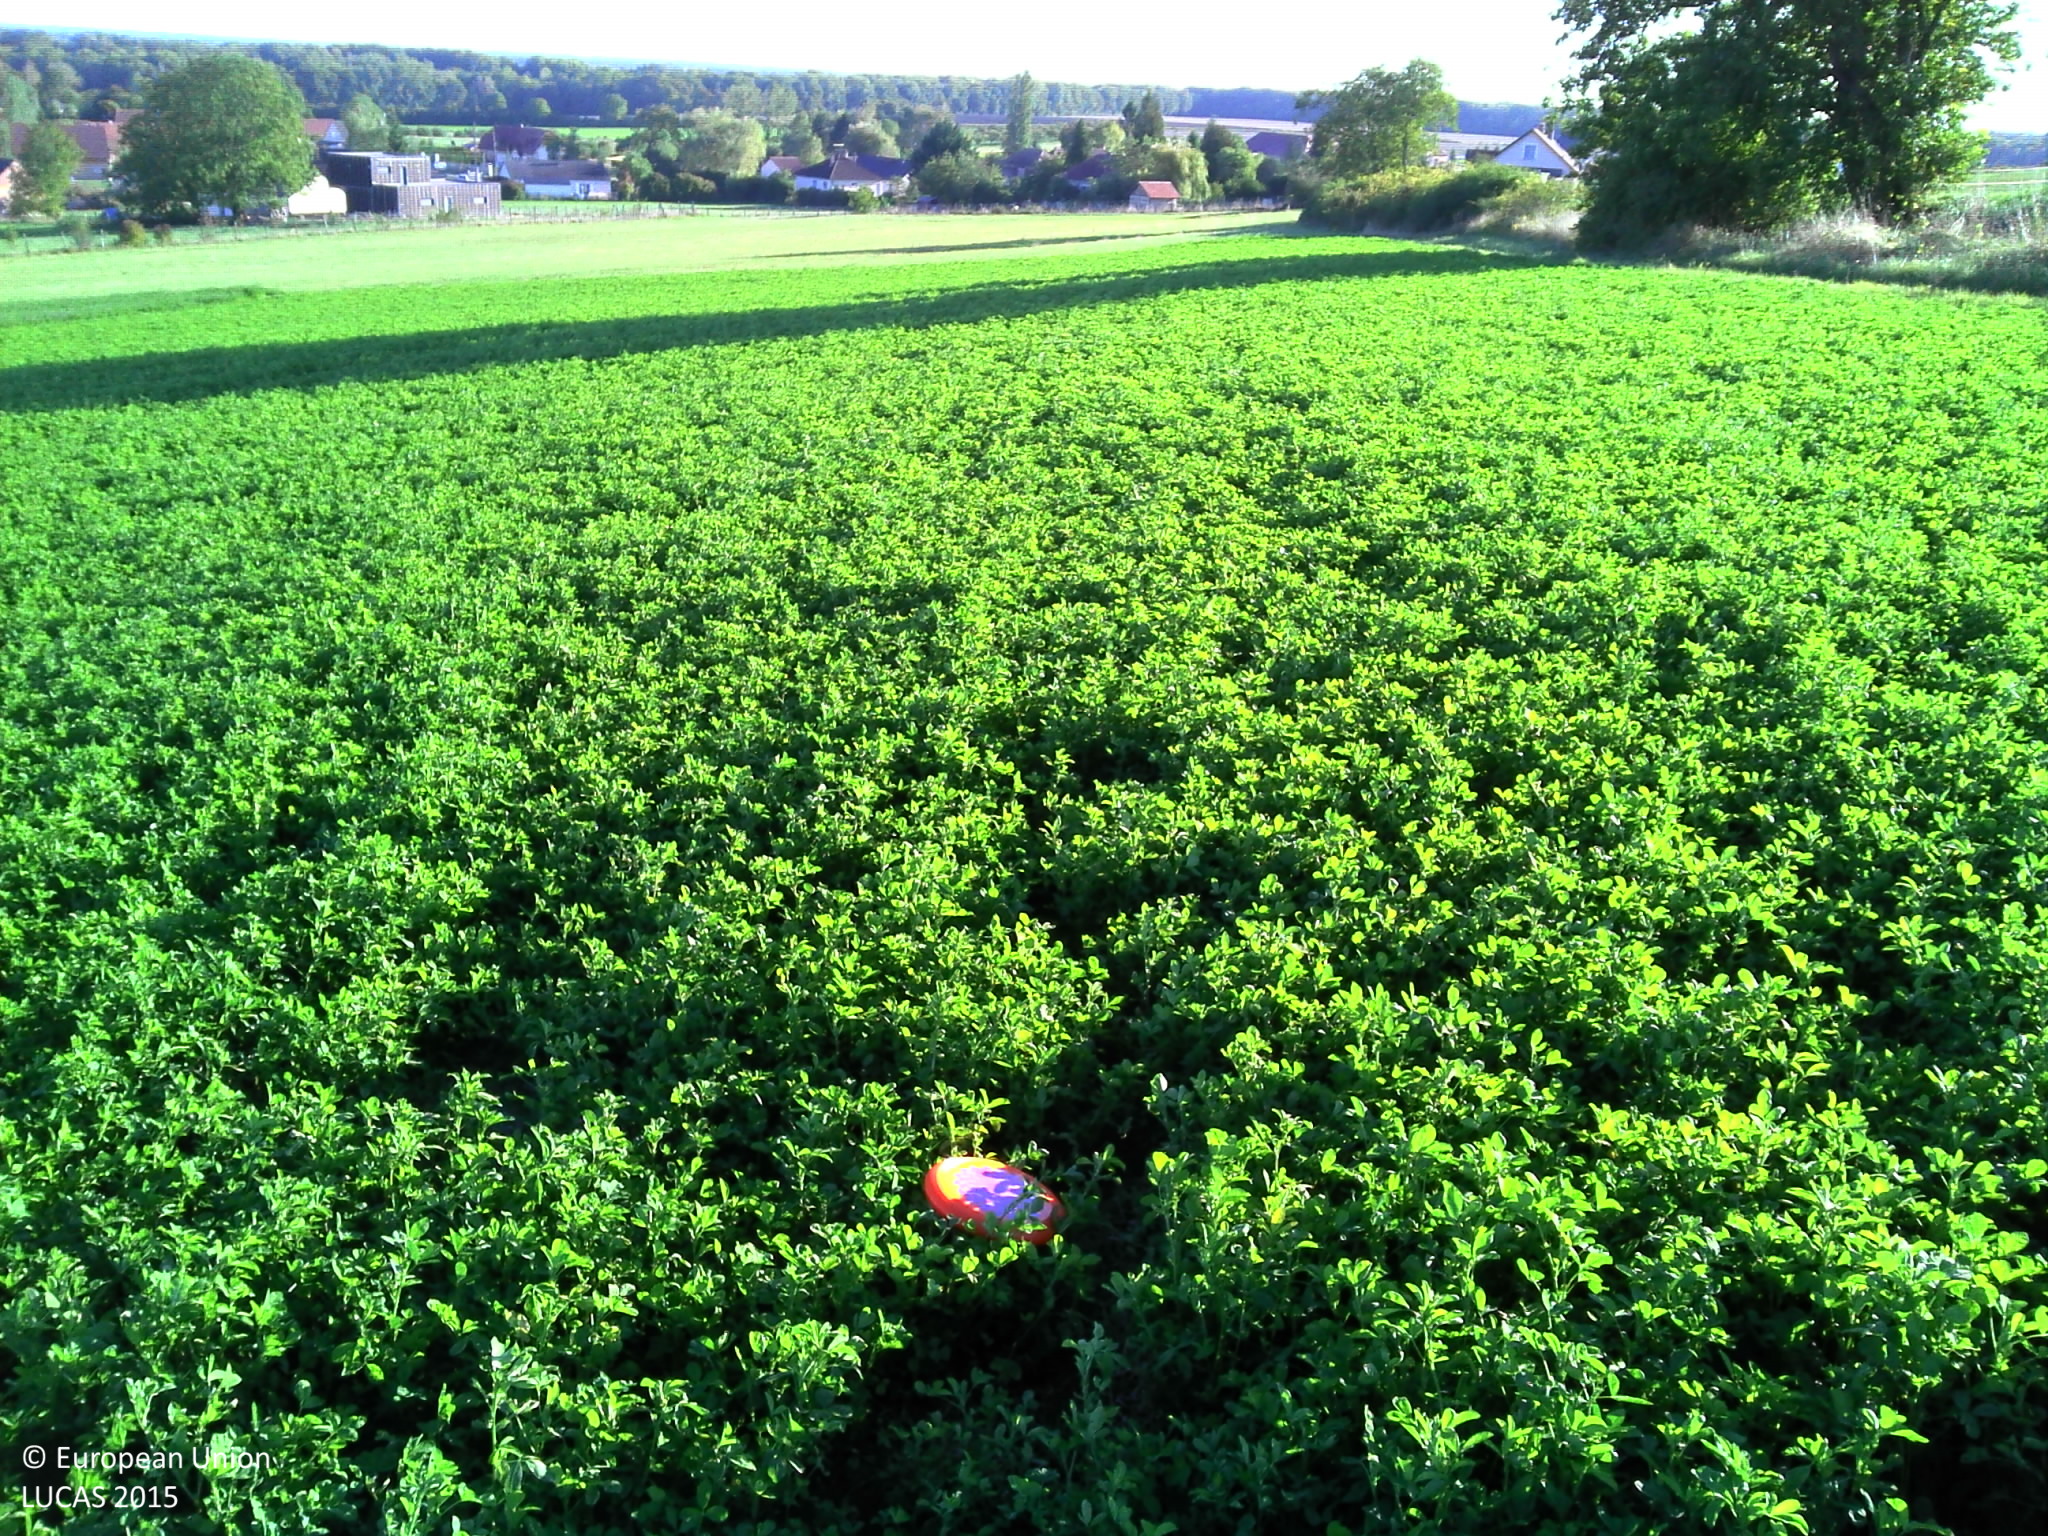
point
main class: Cropland
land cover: Lucerne
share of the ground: > 75 %
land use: Agriculture (excluding fallow land and kitchen gardens)
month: September
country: FR
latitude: 48.3075
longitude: 4.2397
